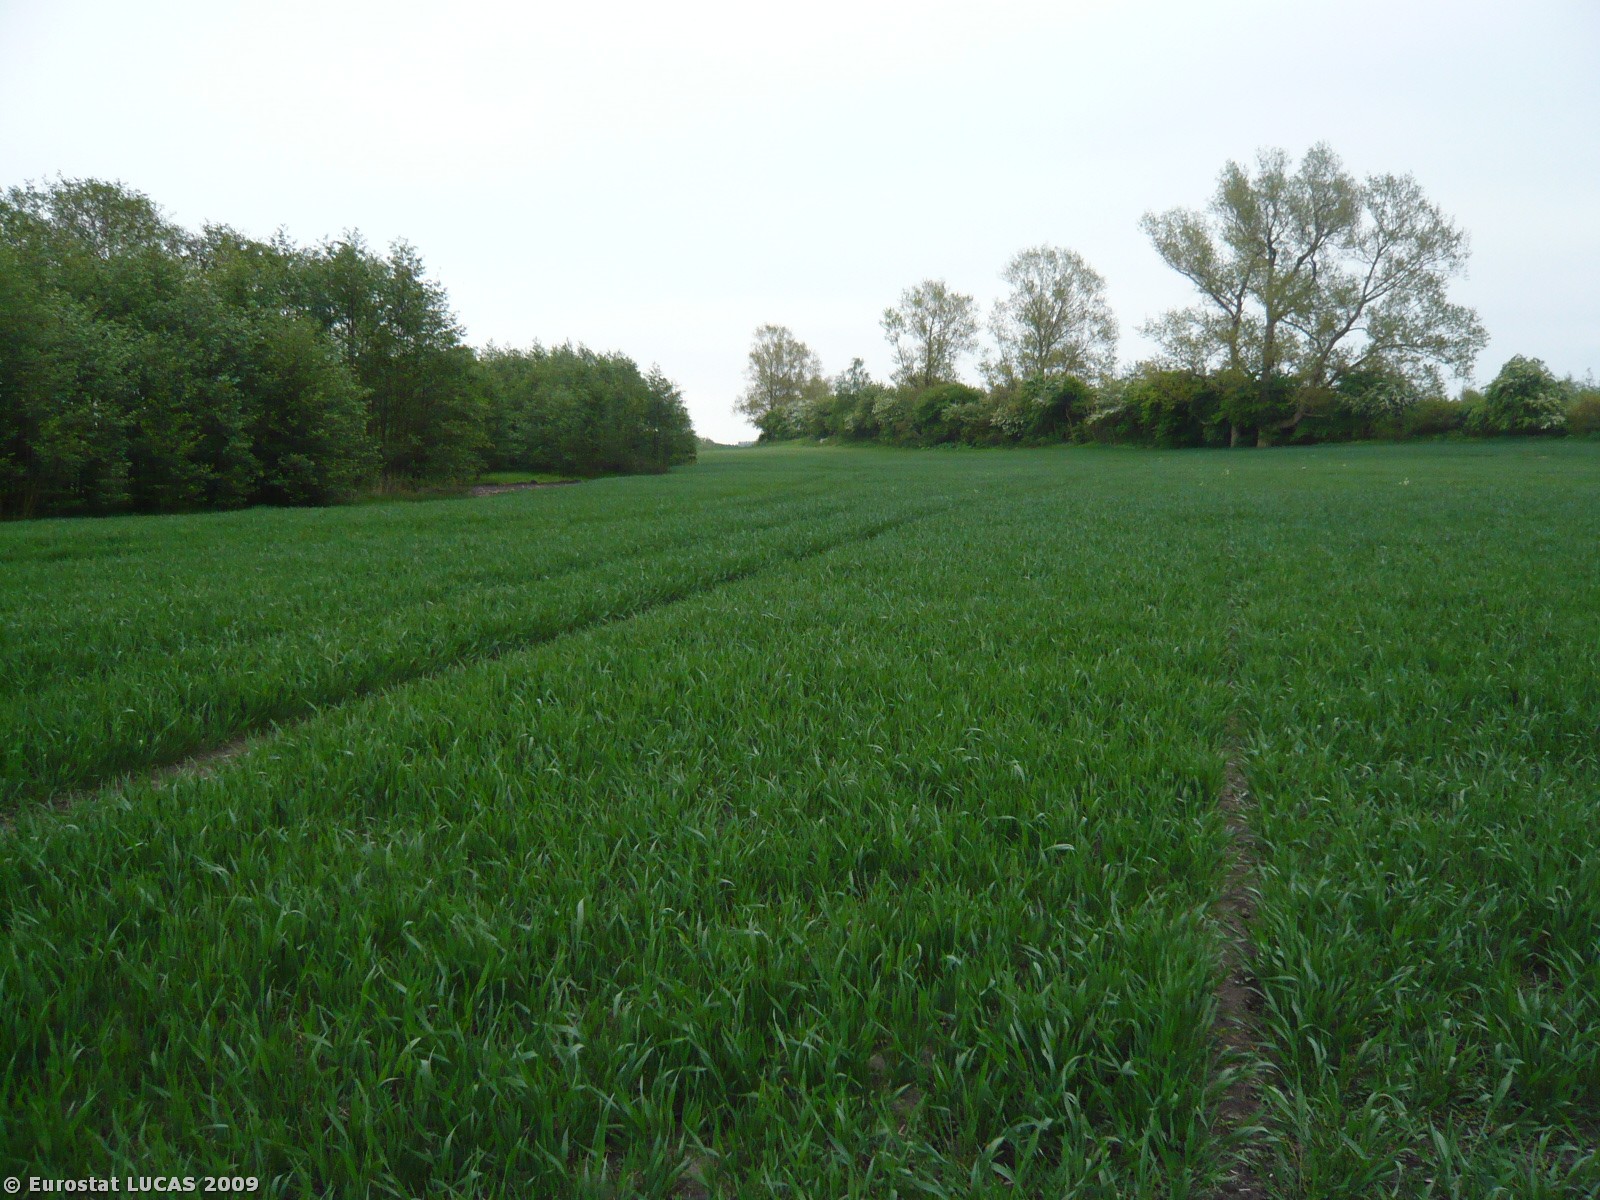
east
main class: Cropland
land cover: Common wheat
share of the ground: > 75 %
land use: Agriculture (excluding fallow land and kitchen gardens)
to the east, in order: Common wheat; Broadleaved woodland
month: May
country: DK
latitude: 55.3990
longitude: 12.0038
